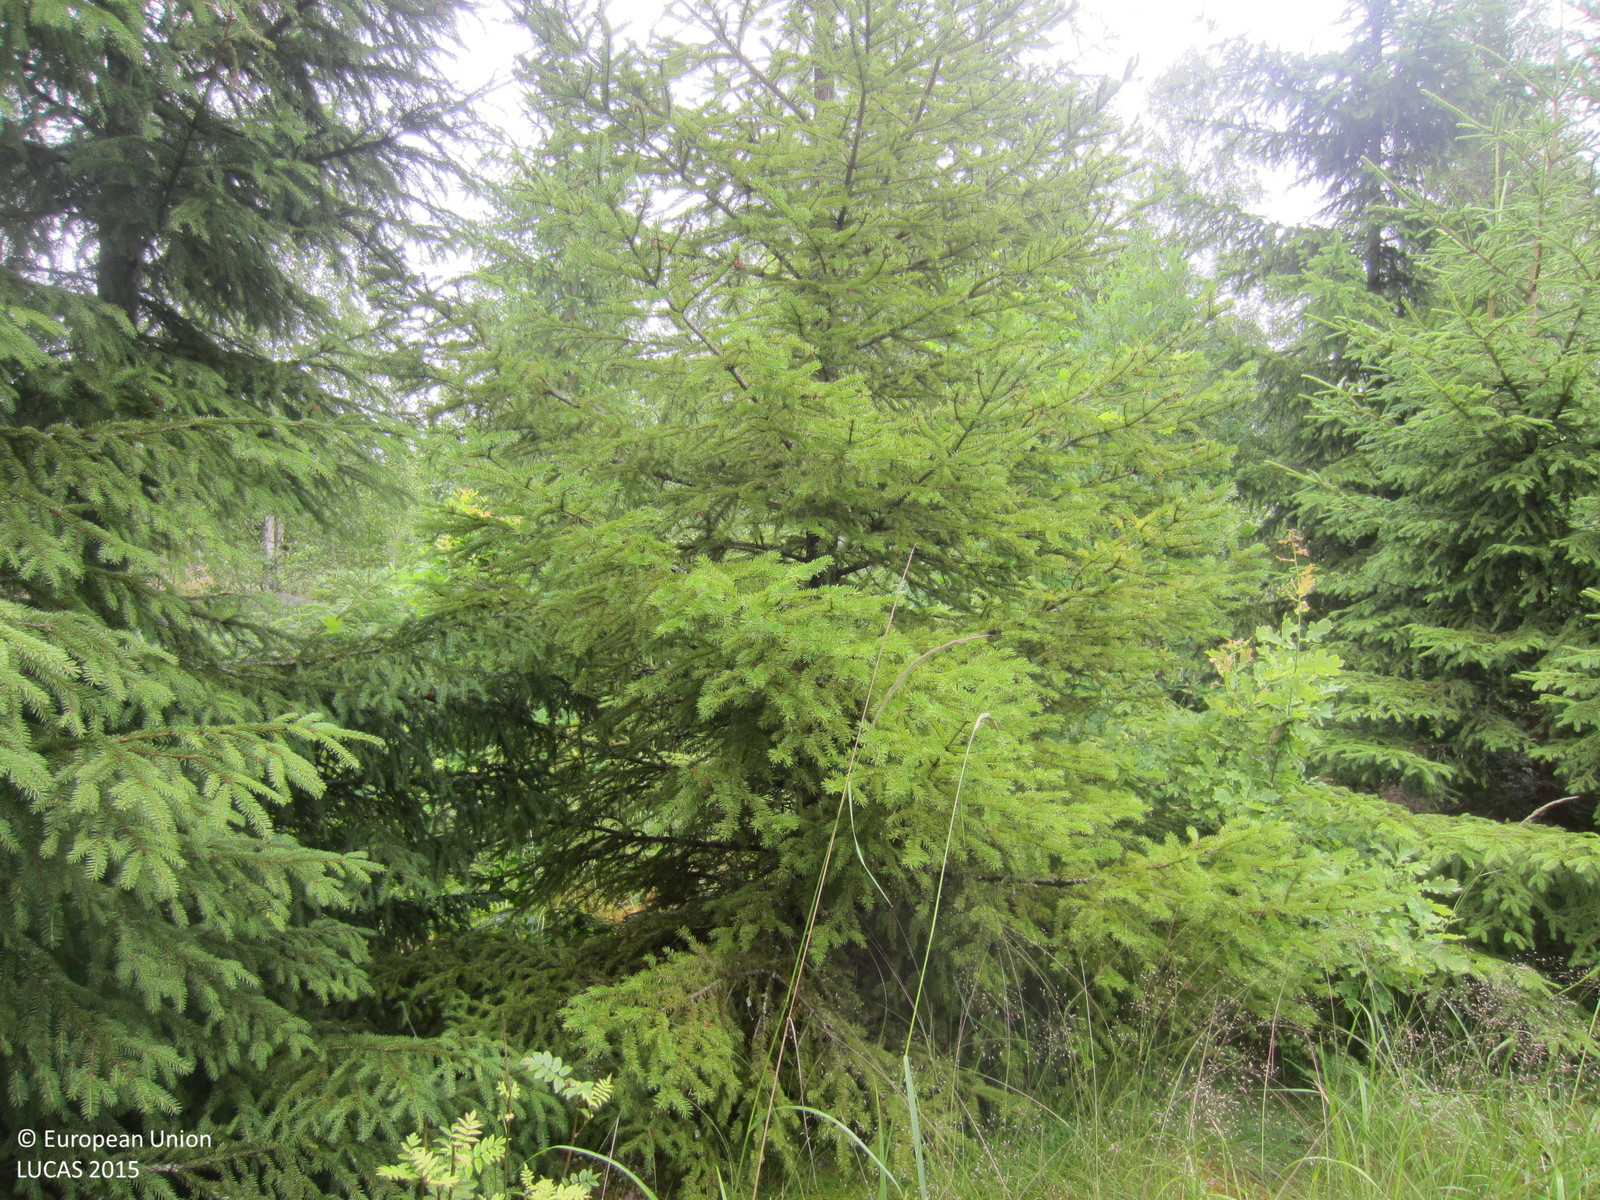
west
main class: Woodland
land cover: Spruce dominated coniferous woodland
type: boreal forest
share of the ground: 50 - 75 %
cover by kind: coniferous forest trees 55 %, herbaceous plants 20 %, lichens and mosses 20 %, broadleaved forest trees 5 %
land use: Forestry
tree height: > 5 m
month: July
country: SE
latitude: 59.8652
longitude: 16.9387
